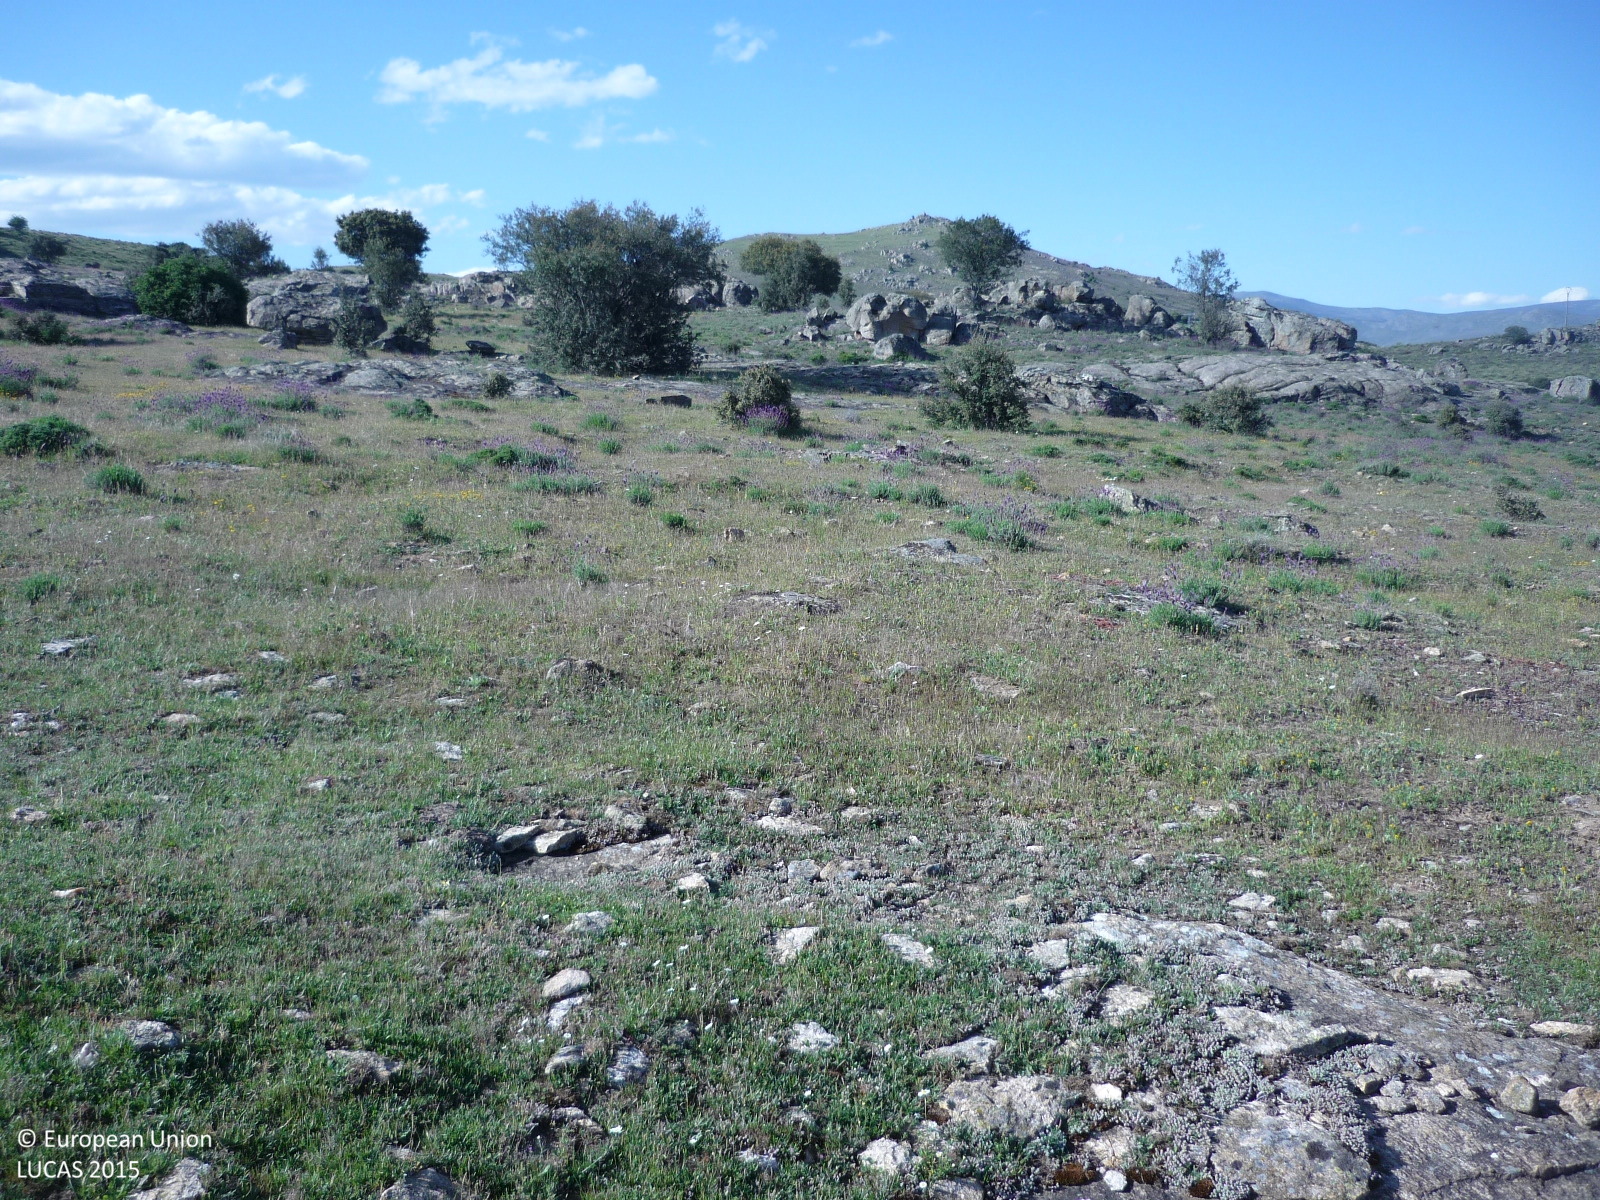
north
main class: Grassland
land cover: Grassland with sparse tree/shrub cover
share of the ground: > 75 %
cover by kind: herbaceous plants 80 %, unconsolidated bare surface 10 %, broadleaved forest trees 5 %, shrubs 5 %
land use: Agriculture (excluding fallow land and kitchen gardens)
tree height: < 5 m
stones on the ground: < 10 %
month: May
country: ES
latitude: 41.0167
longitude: -3.6121
